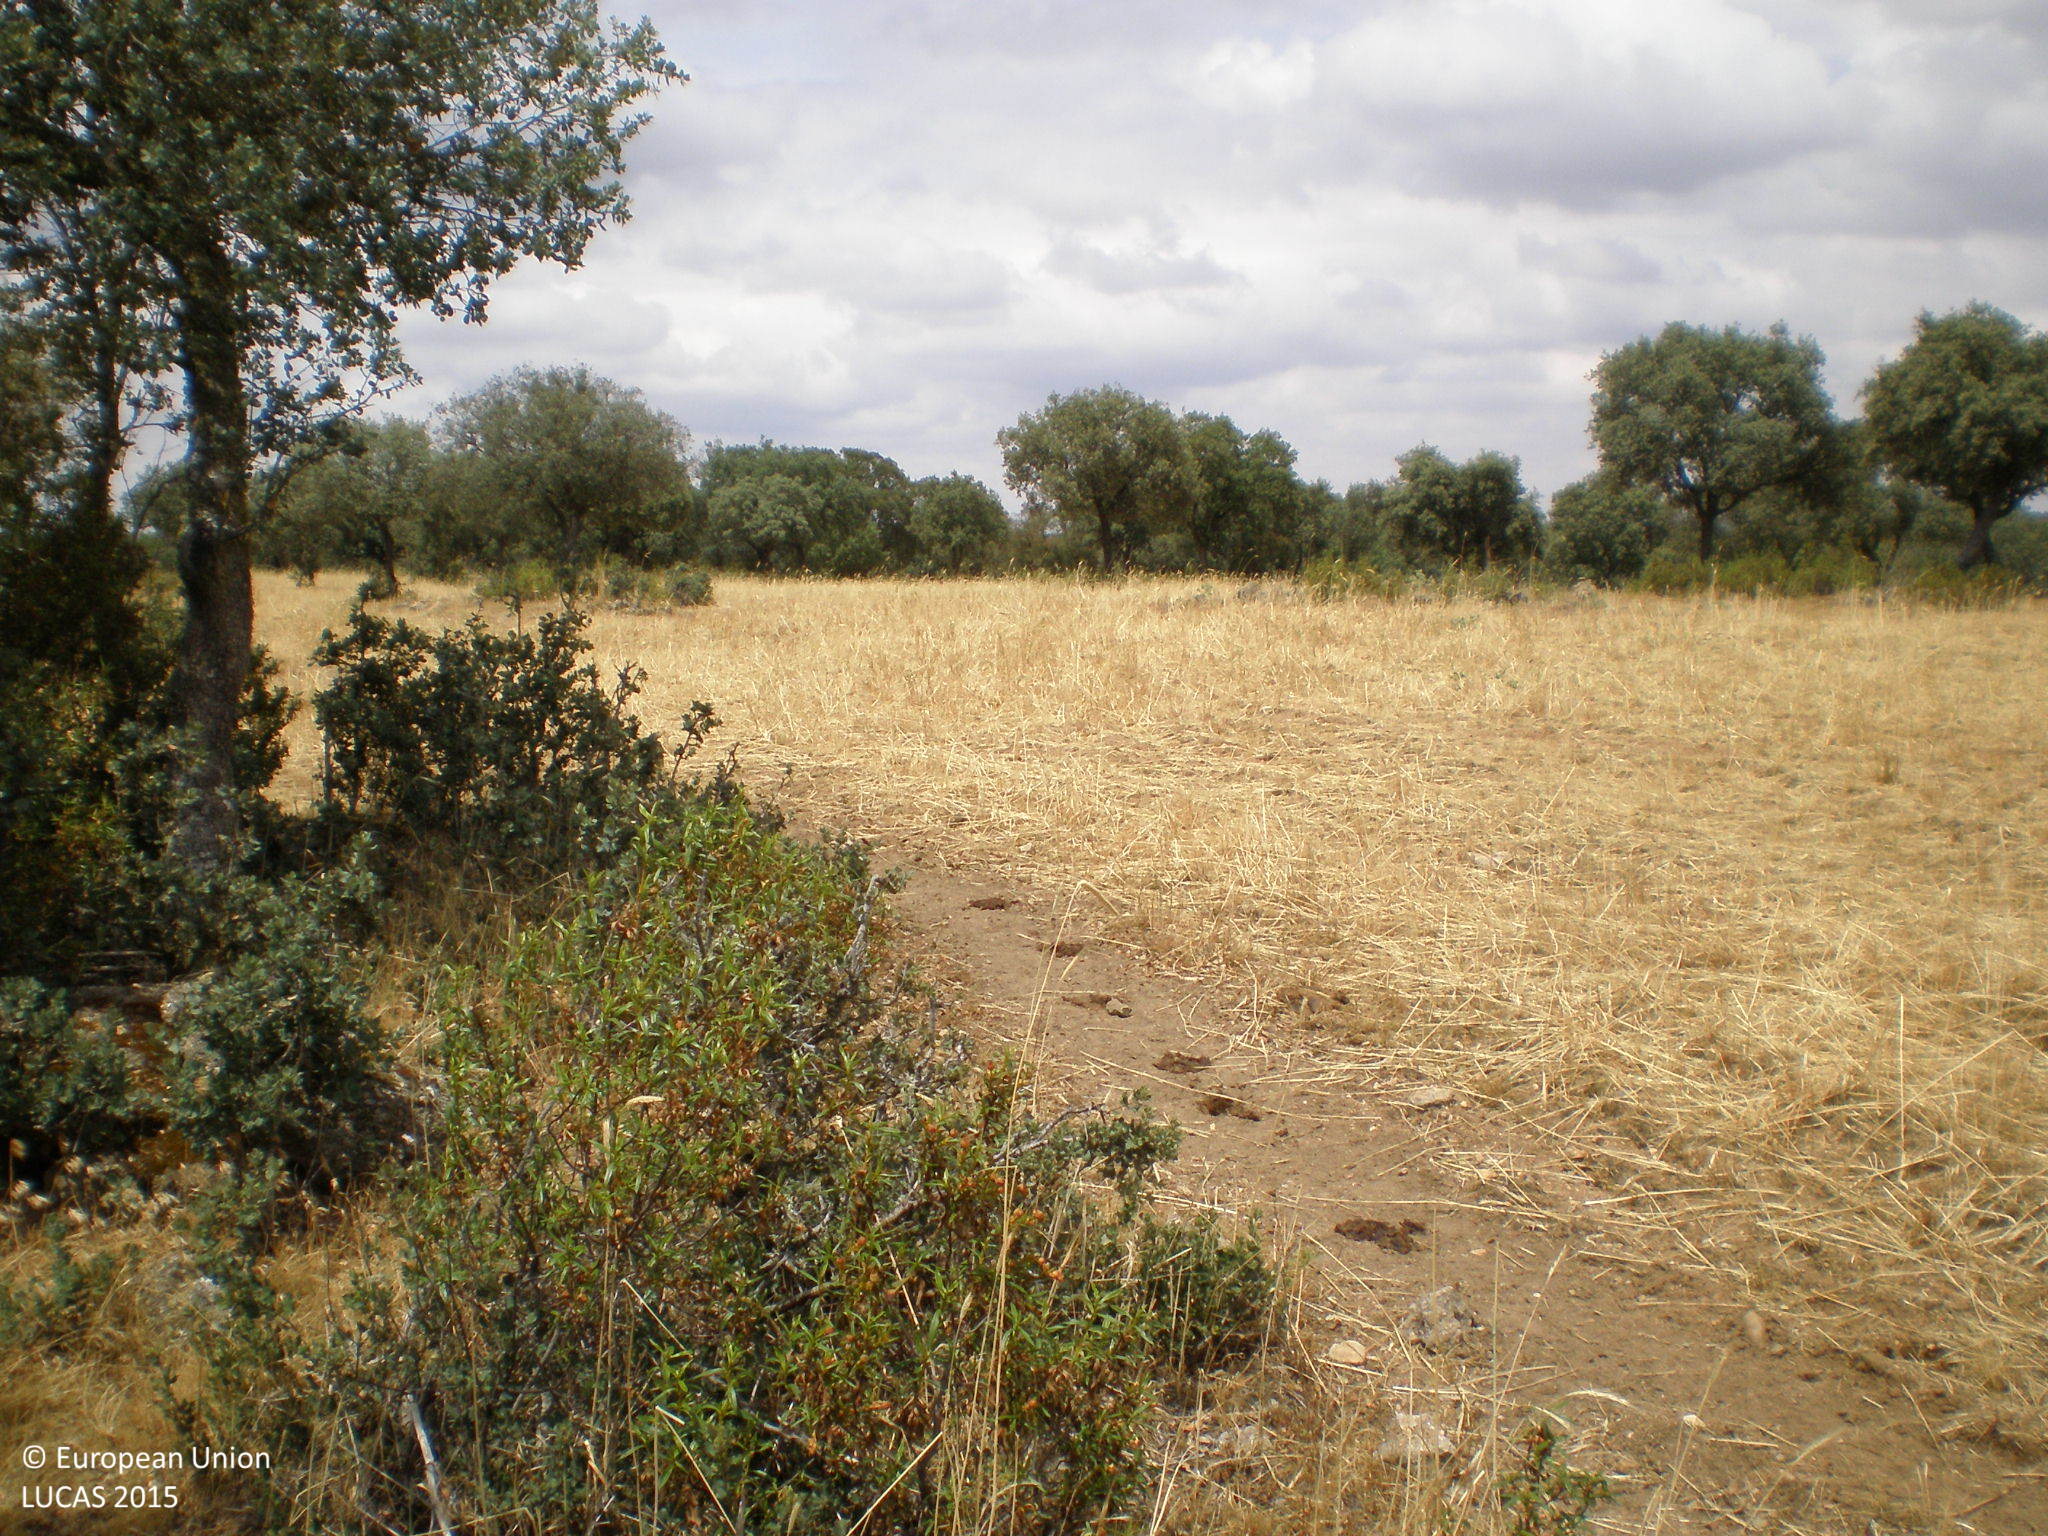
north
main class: Woodland
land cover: Broadleaved woodland
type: broadleaved evergreen forest
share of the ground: 25 - 50 %
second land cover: Rye
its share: 50 - 75 %
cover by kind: herbaceous plants 70 %, broadleaved forest trees 30 %
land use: Forestry
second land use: Agriculture (excluding fallow land and kitchen gardens)
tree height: < 5 m
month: June
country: ES
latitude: 41.1376
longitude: -5.7474
